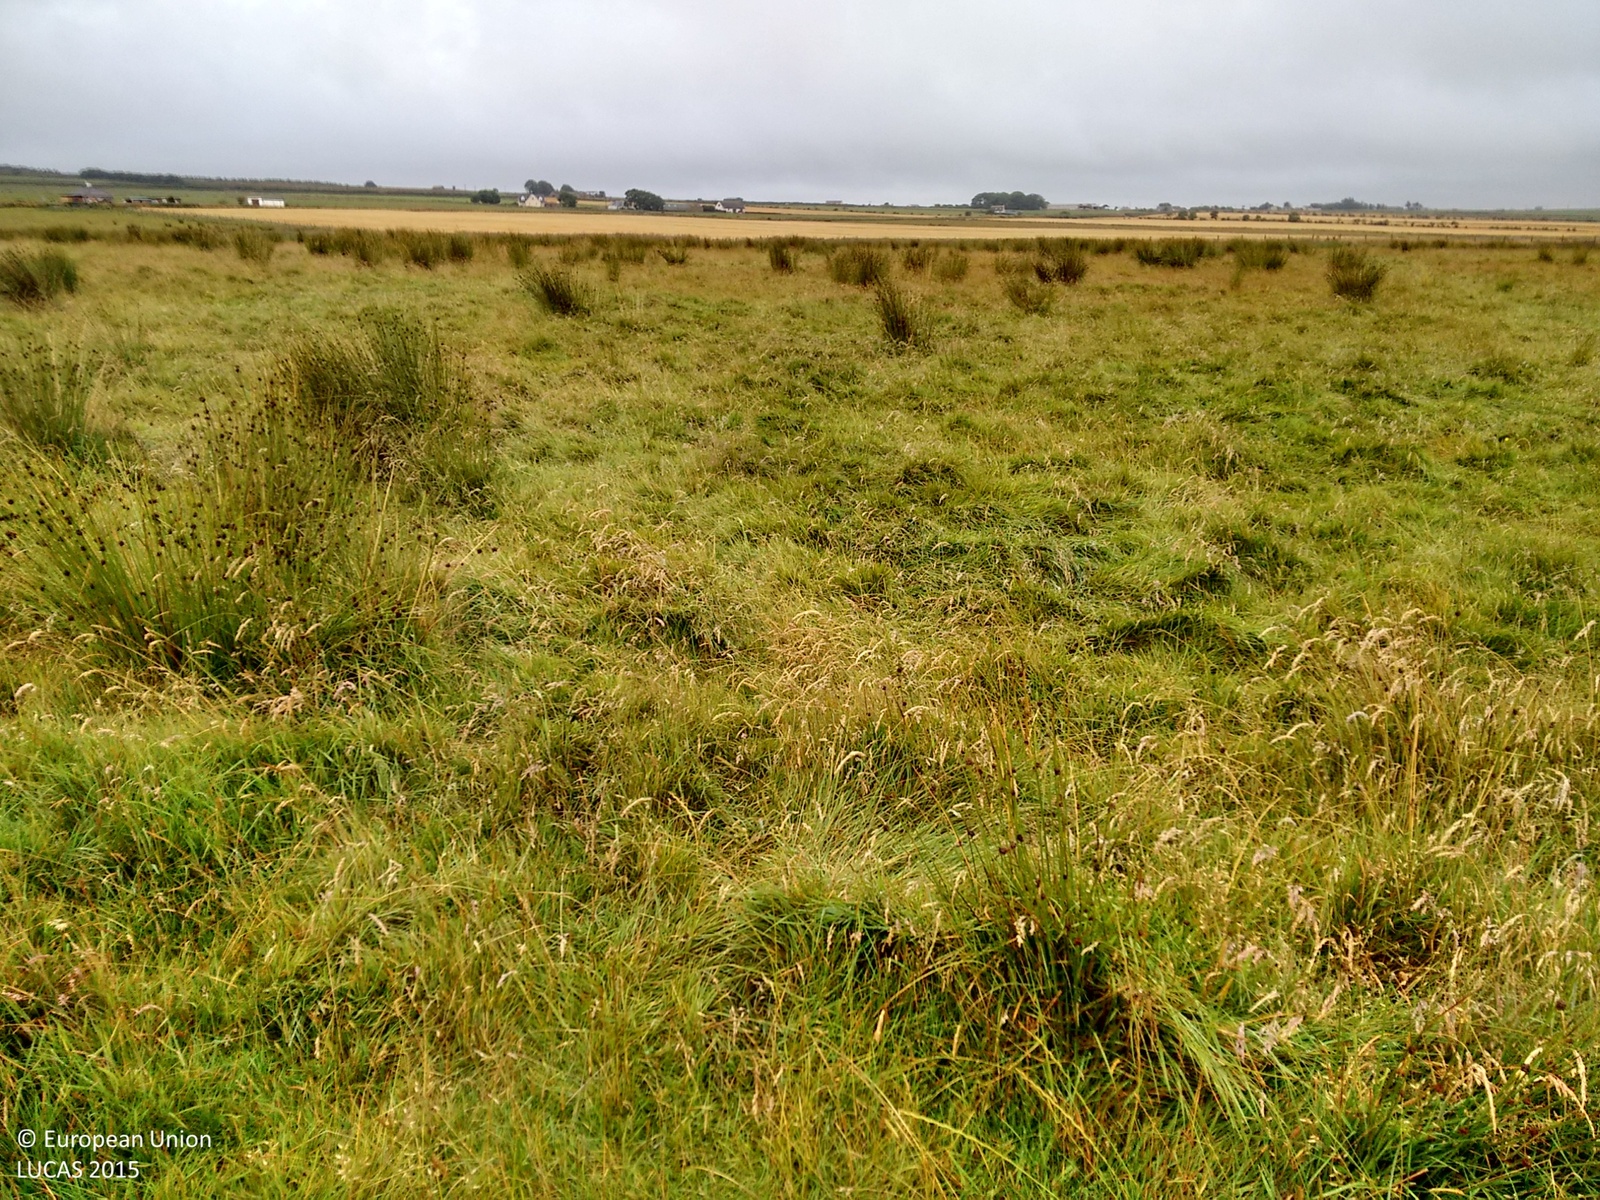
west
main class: Grassland
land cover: Grassland without tree/shrub cover
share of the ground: > 75 %
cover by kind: herbaceous plants 100 %
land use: Agriculture (excluding fallow land and kitchen gardens)
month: September
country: GB
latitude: 58.5130
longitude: -3.4003
